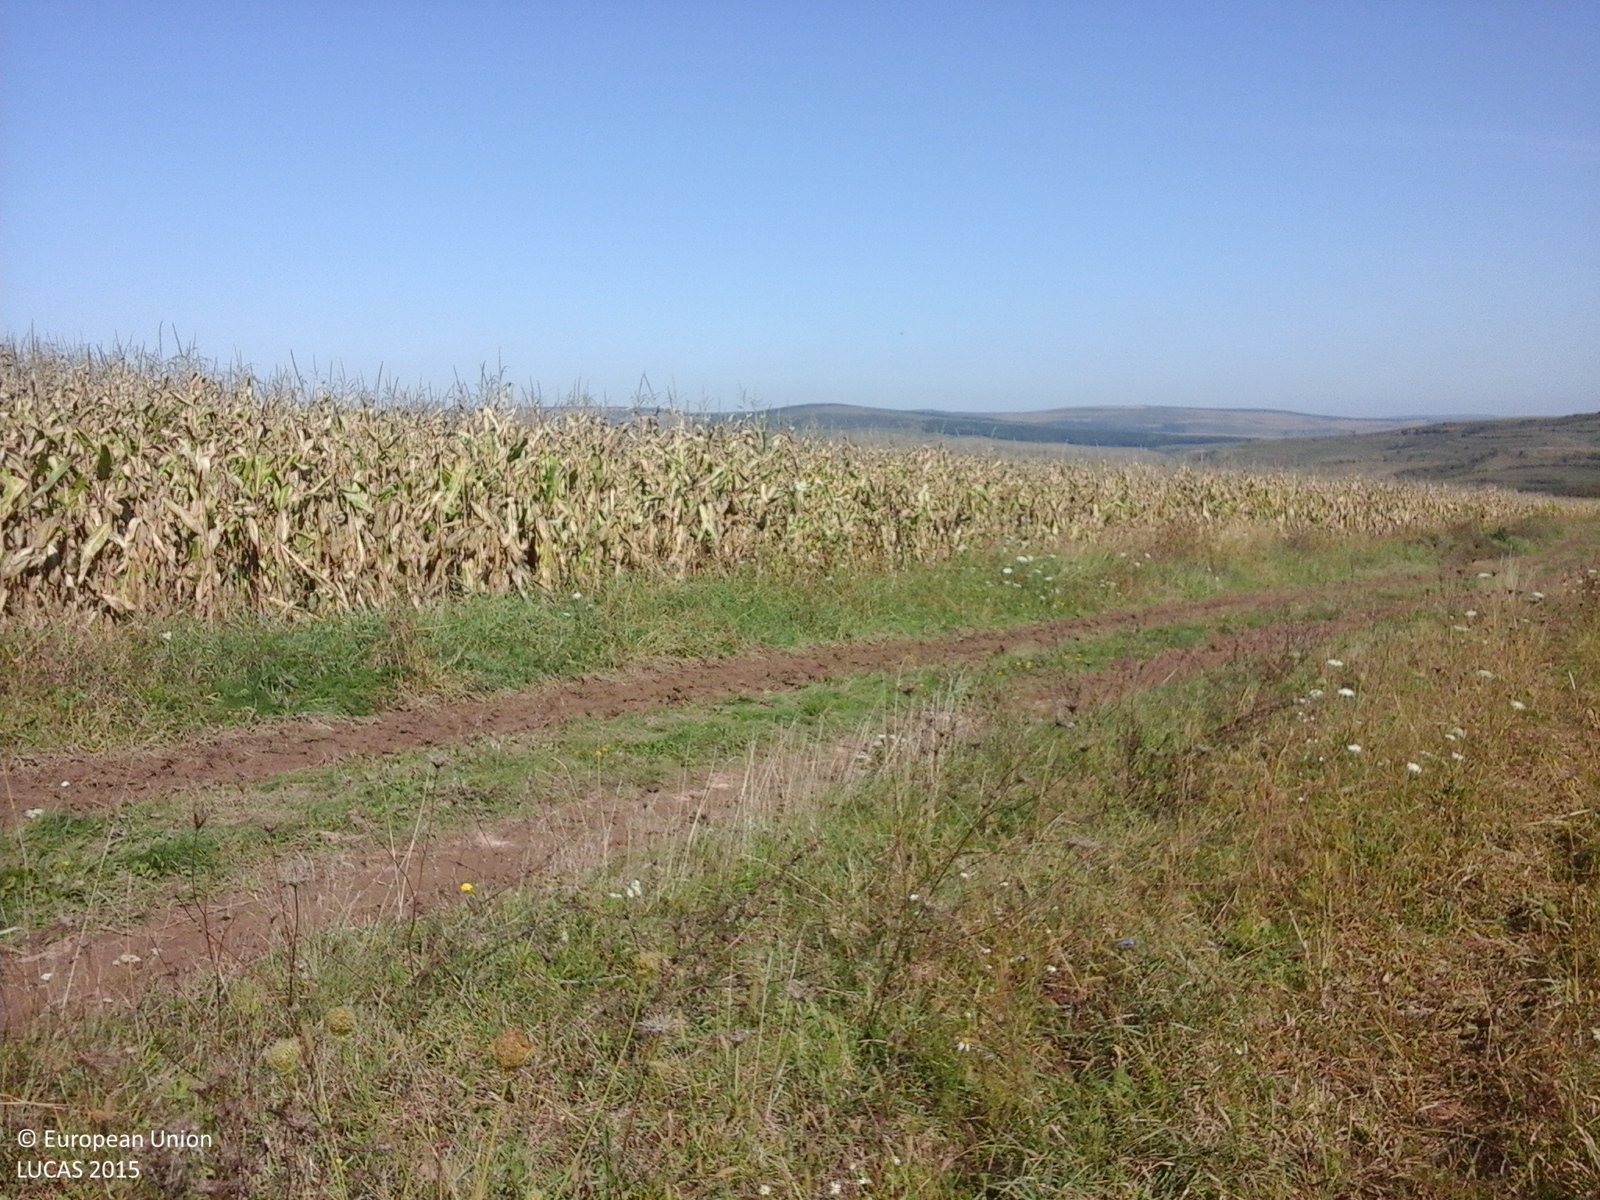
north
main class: Cropland
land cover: Maize
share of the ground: > 75 %
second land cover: Spontaneously vegetated surfaces
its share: 10 - 25 %
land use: Agriculture (excluding fallow land and kitchen gardens)
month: October
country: RO
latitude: 46.5762
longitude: 23.5747
